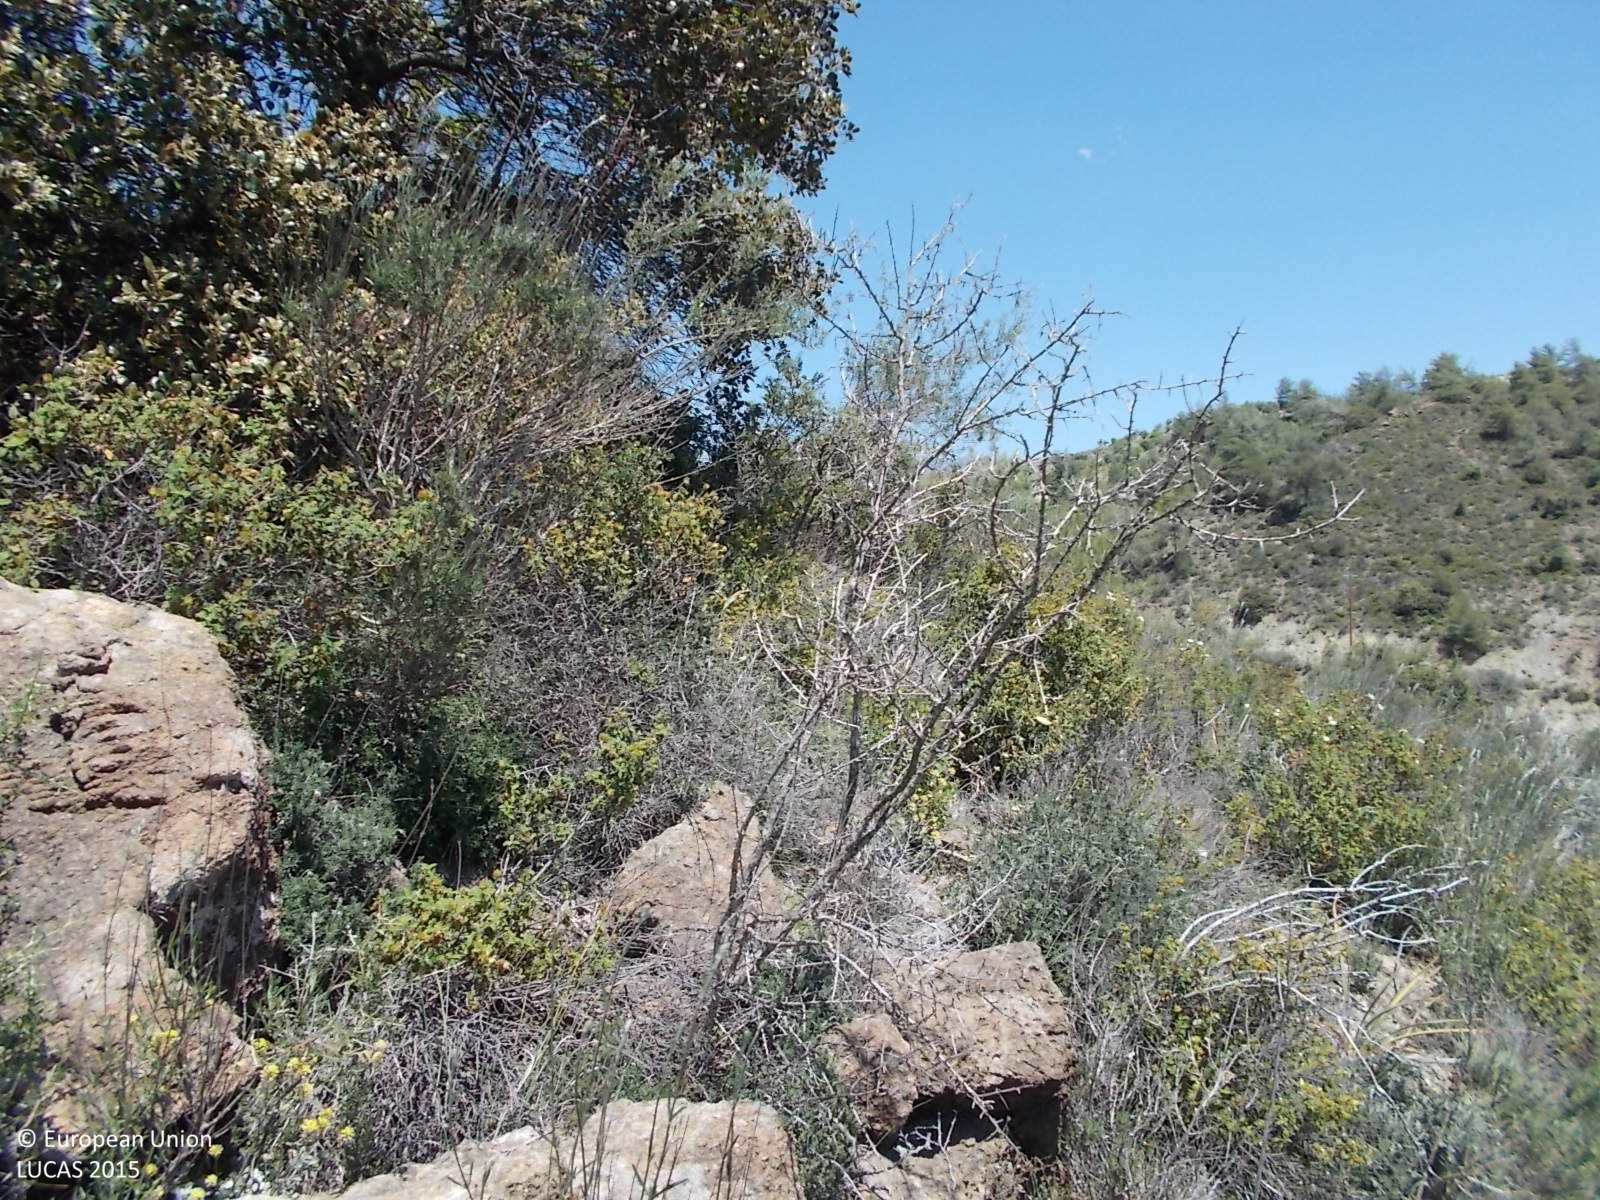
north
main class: Shrubland
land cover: Shrubland with sparse tree cover
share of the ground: > 75 %
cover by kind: shrubs 75 %, unconsolidated bare surface 20 %, broadleaved forest trees 5 %
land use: Semi-natural and natural areas not in use
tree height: < 5 m
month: May
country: CY
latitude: 34.8236
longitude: 33.0308
